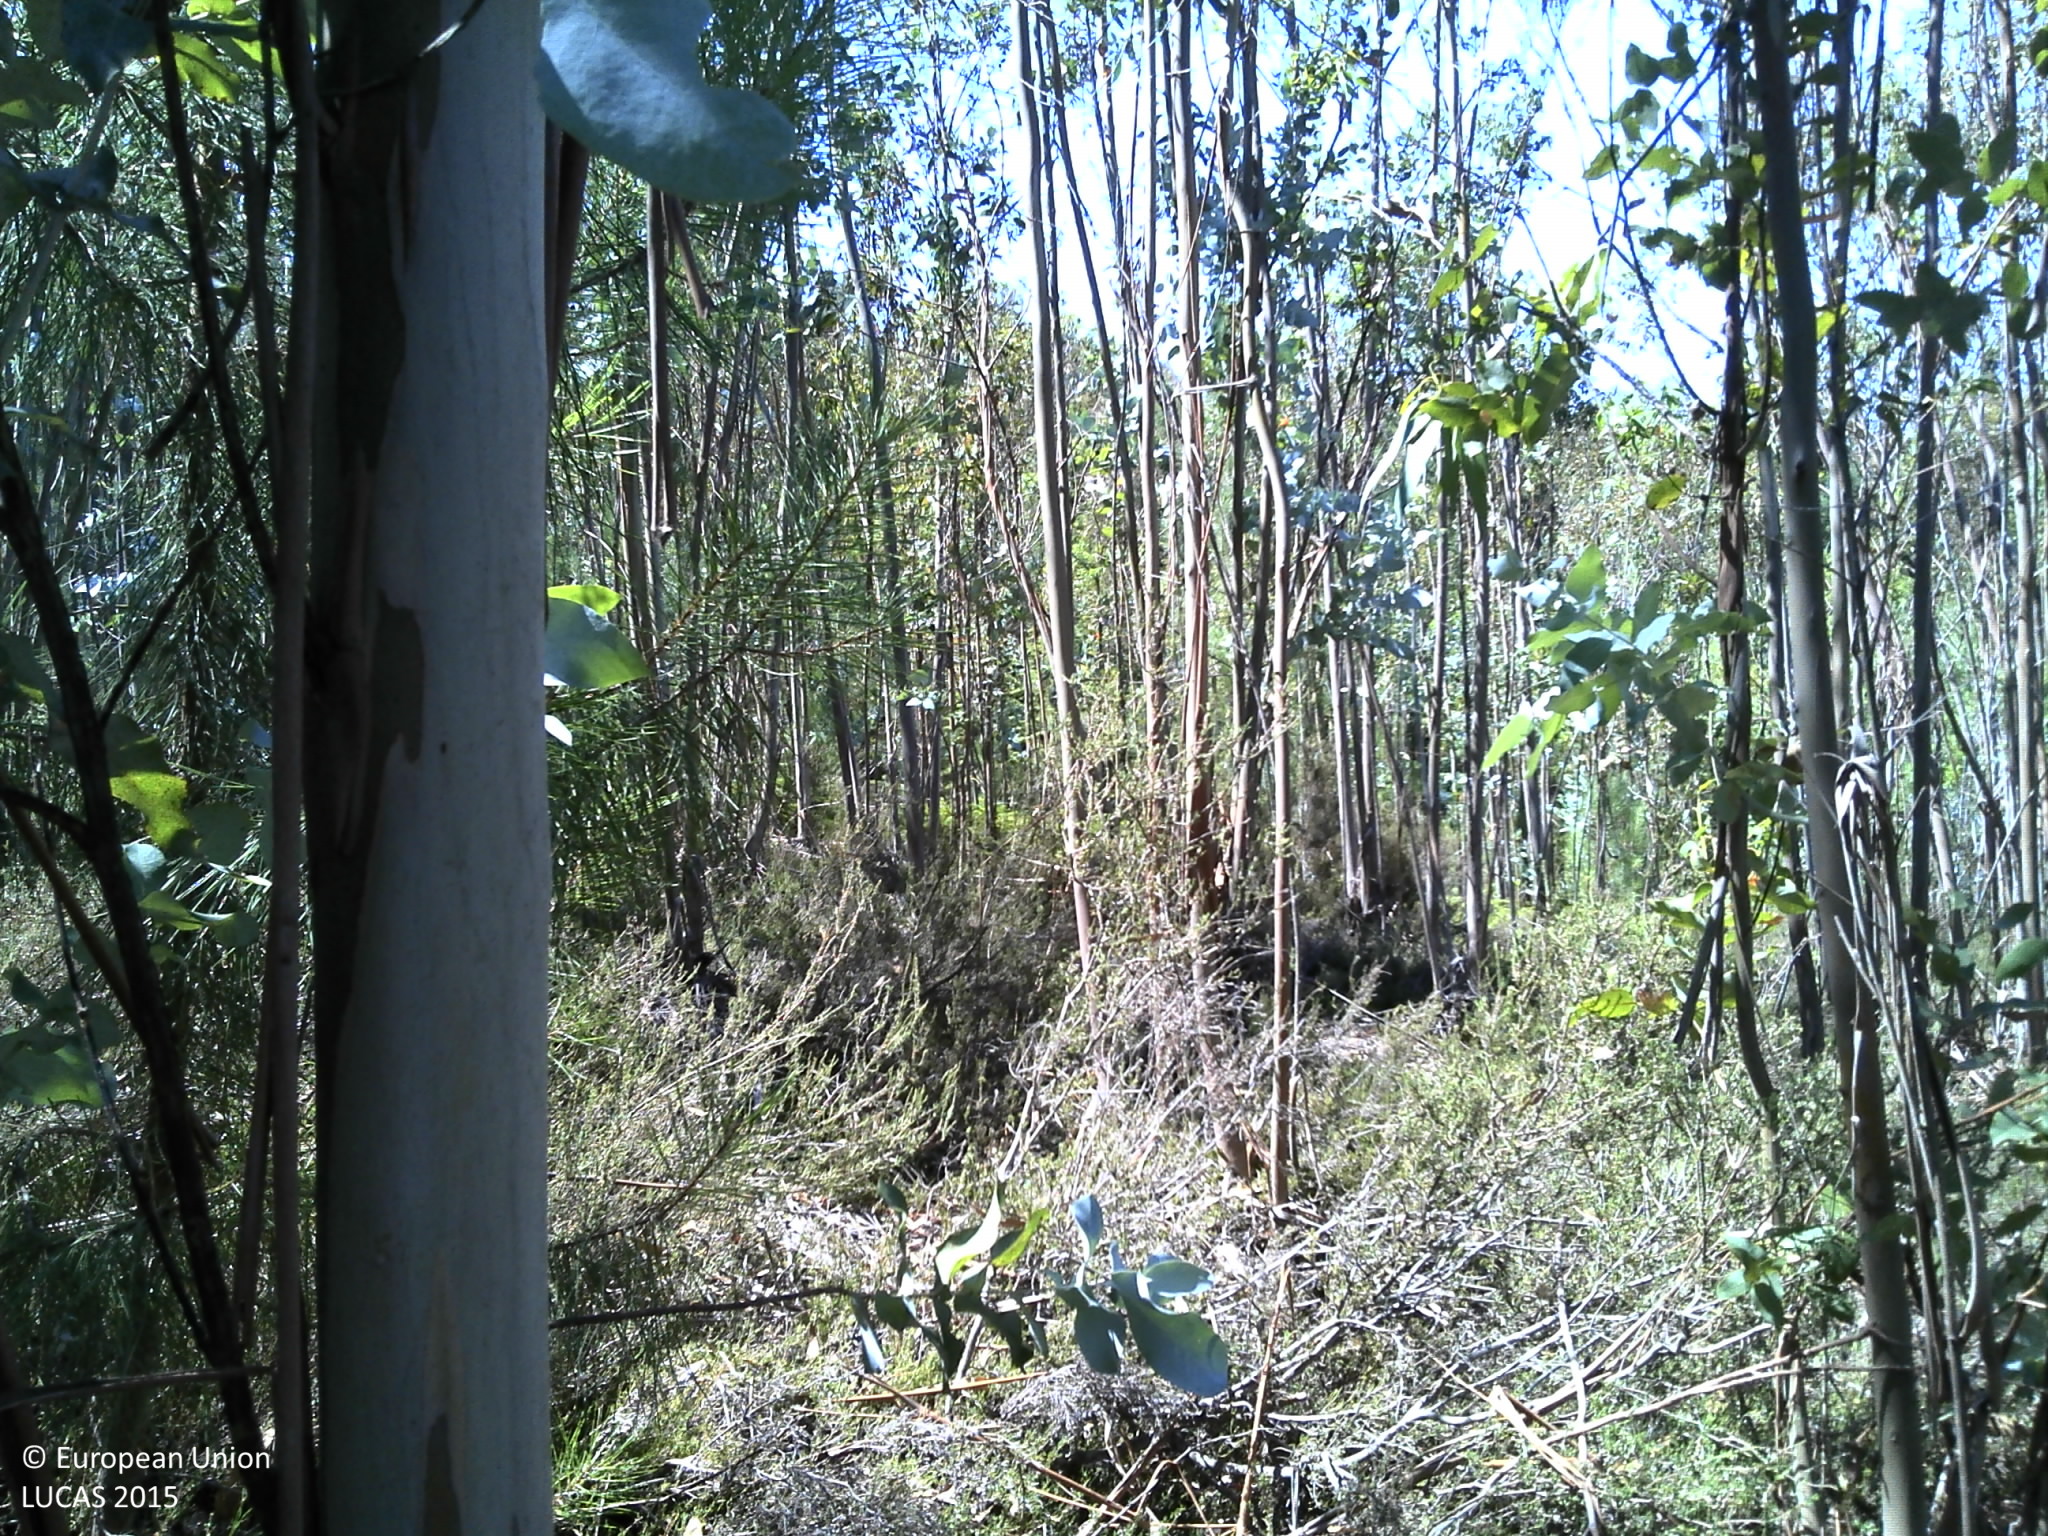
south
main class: Woodland
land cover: Broadleaved woodland
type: exotic forest
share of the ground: 10 - 25 %
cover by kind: shrubs 80 %, broadleaved forest trees 15 %, unconsolidated bare surface 5 %
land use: Forestry
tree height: > 5 m
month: July
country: PT
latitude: 40.0099
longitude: -8.1967
